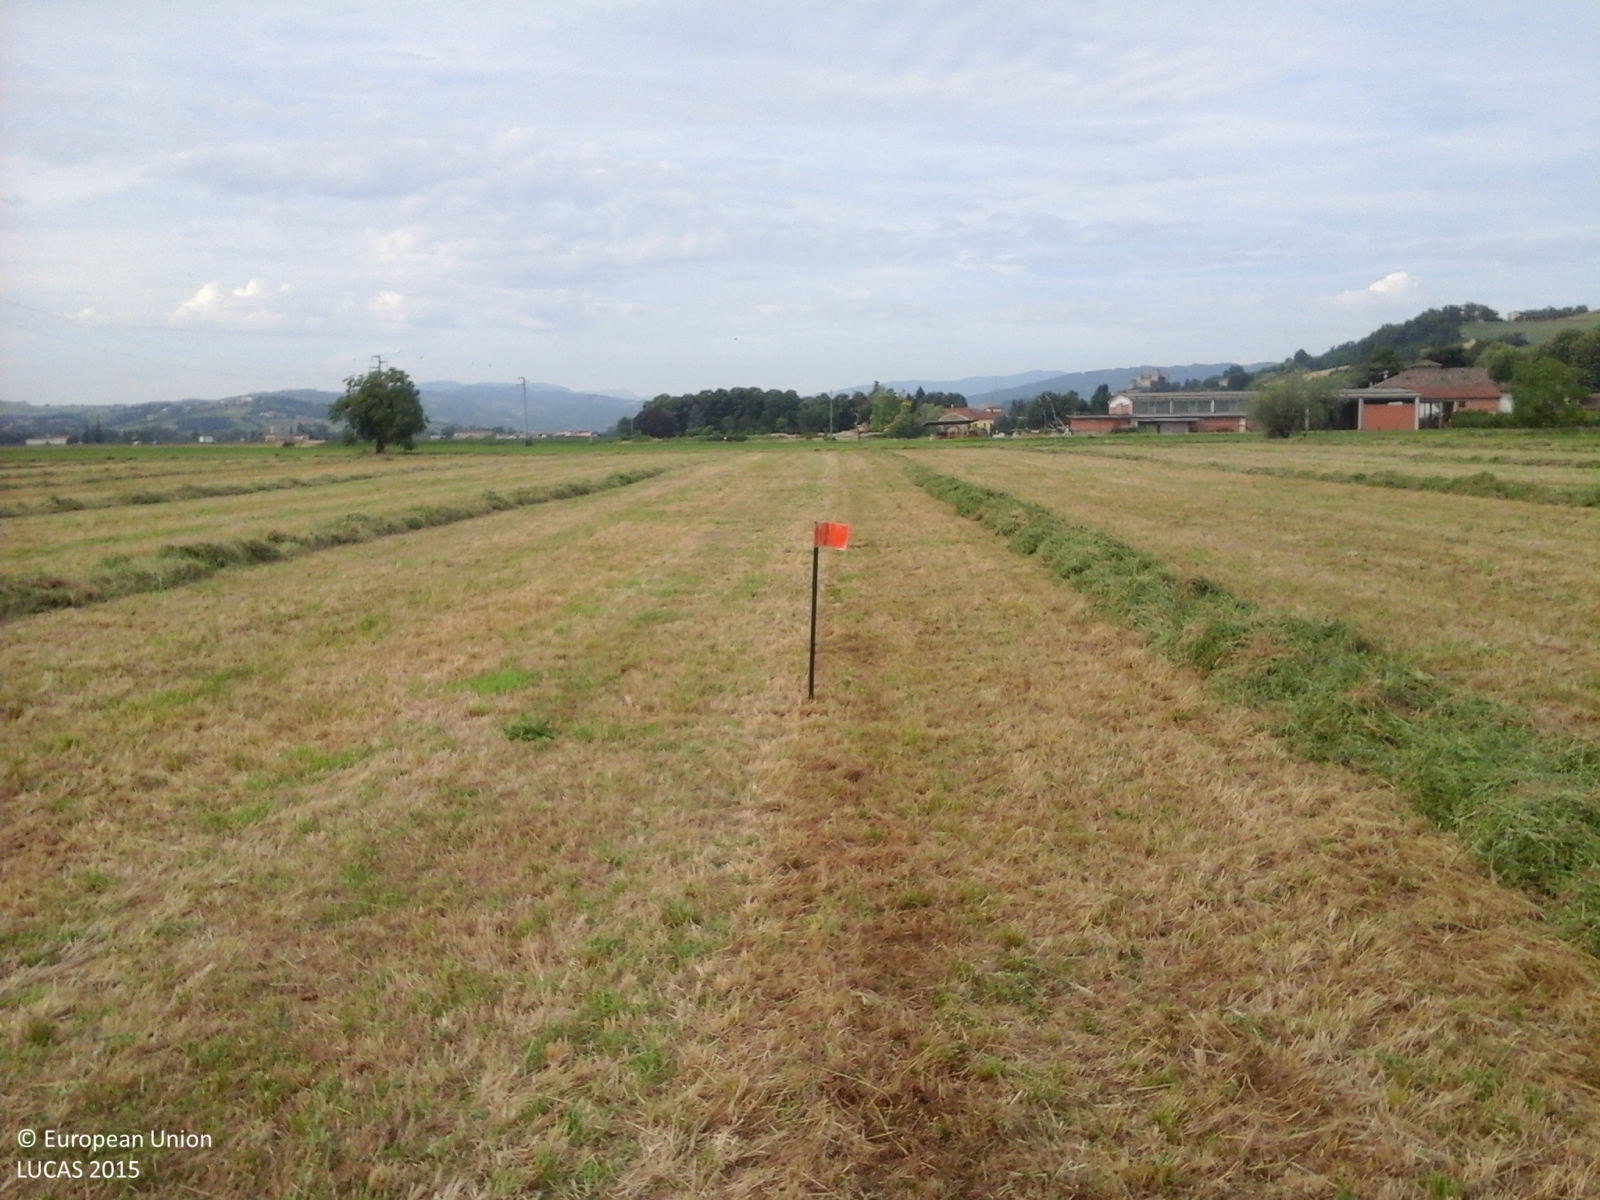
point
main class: Cropland
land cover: Lucerne
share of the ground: > 75 %
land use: Agriculture (excluding fallow land and kitchen gardens)
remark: Clear cut
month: June
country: IT
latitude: 44.6748
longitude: 10.2895
